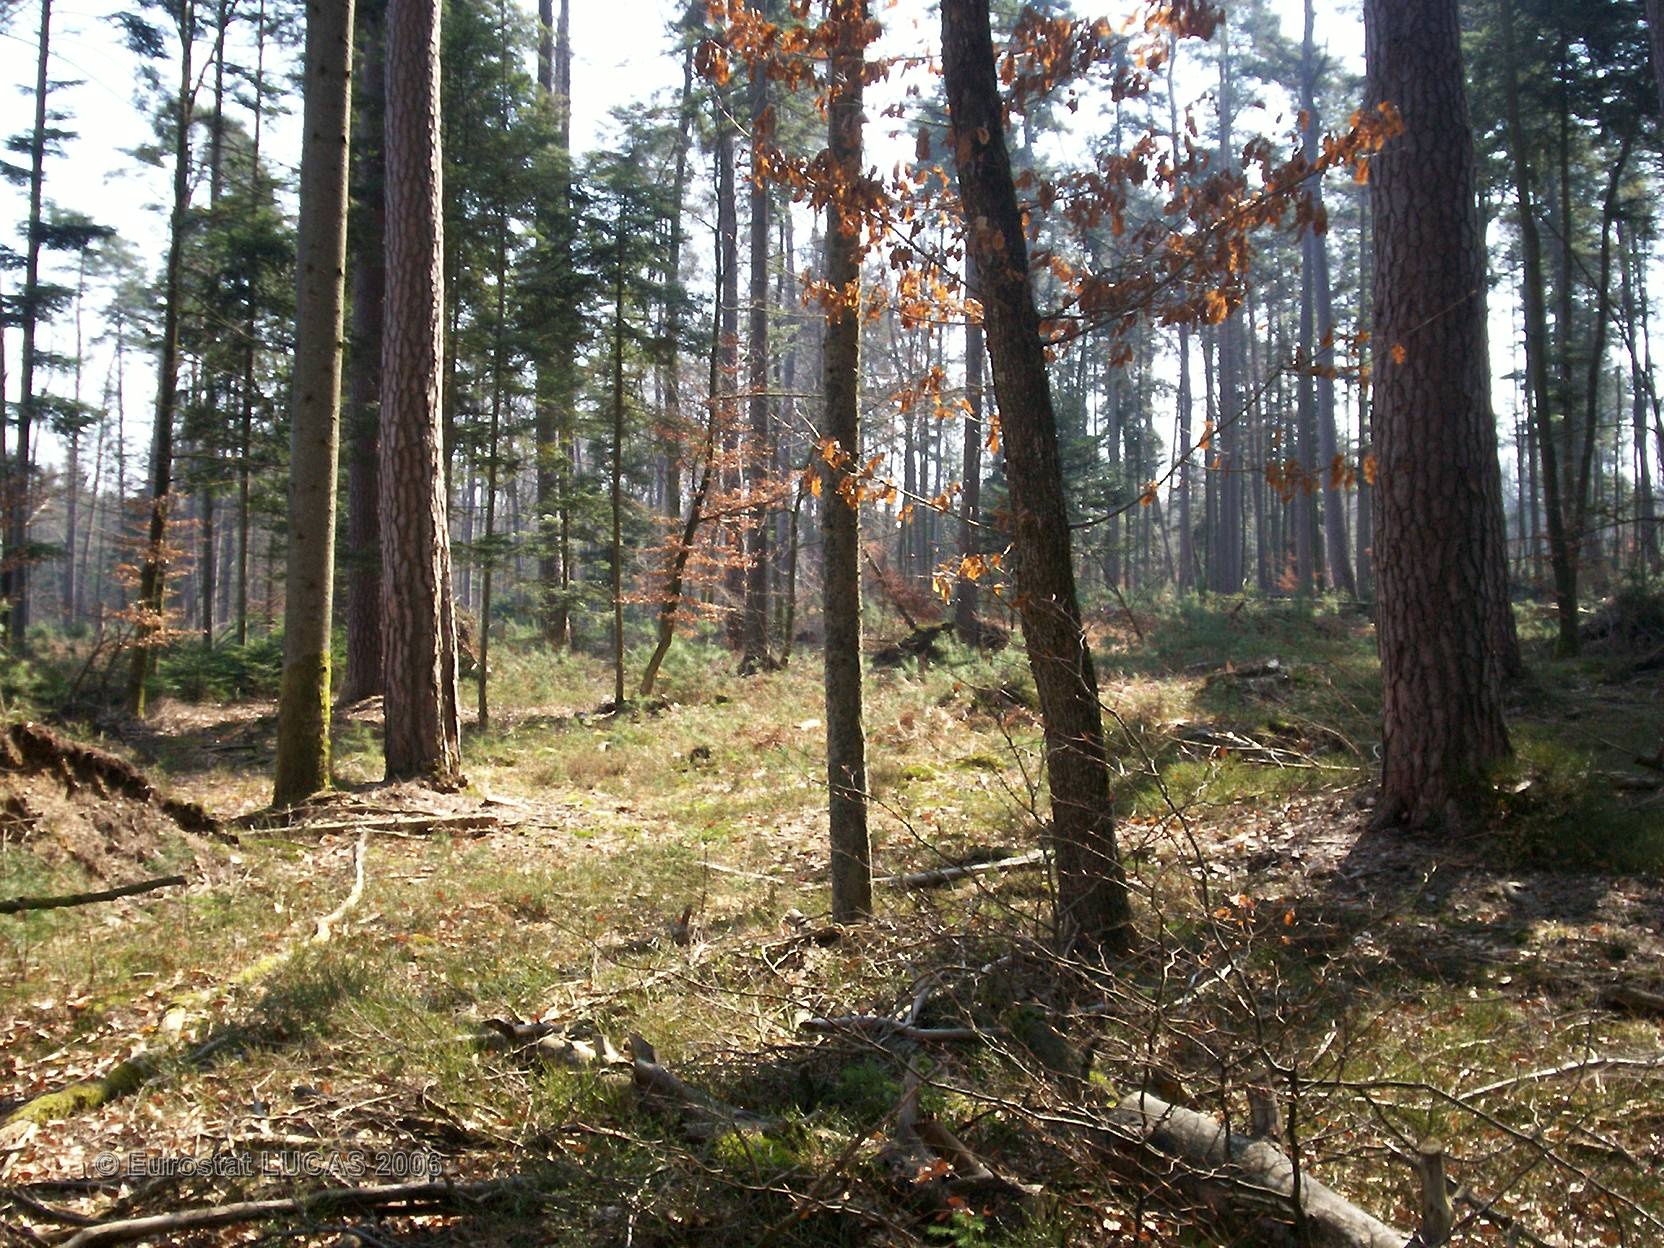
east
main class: Woodland
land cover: Coniferous forest
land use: Forestry
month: April
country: FR
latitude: 48.2071
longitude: 6.5963
